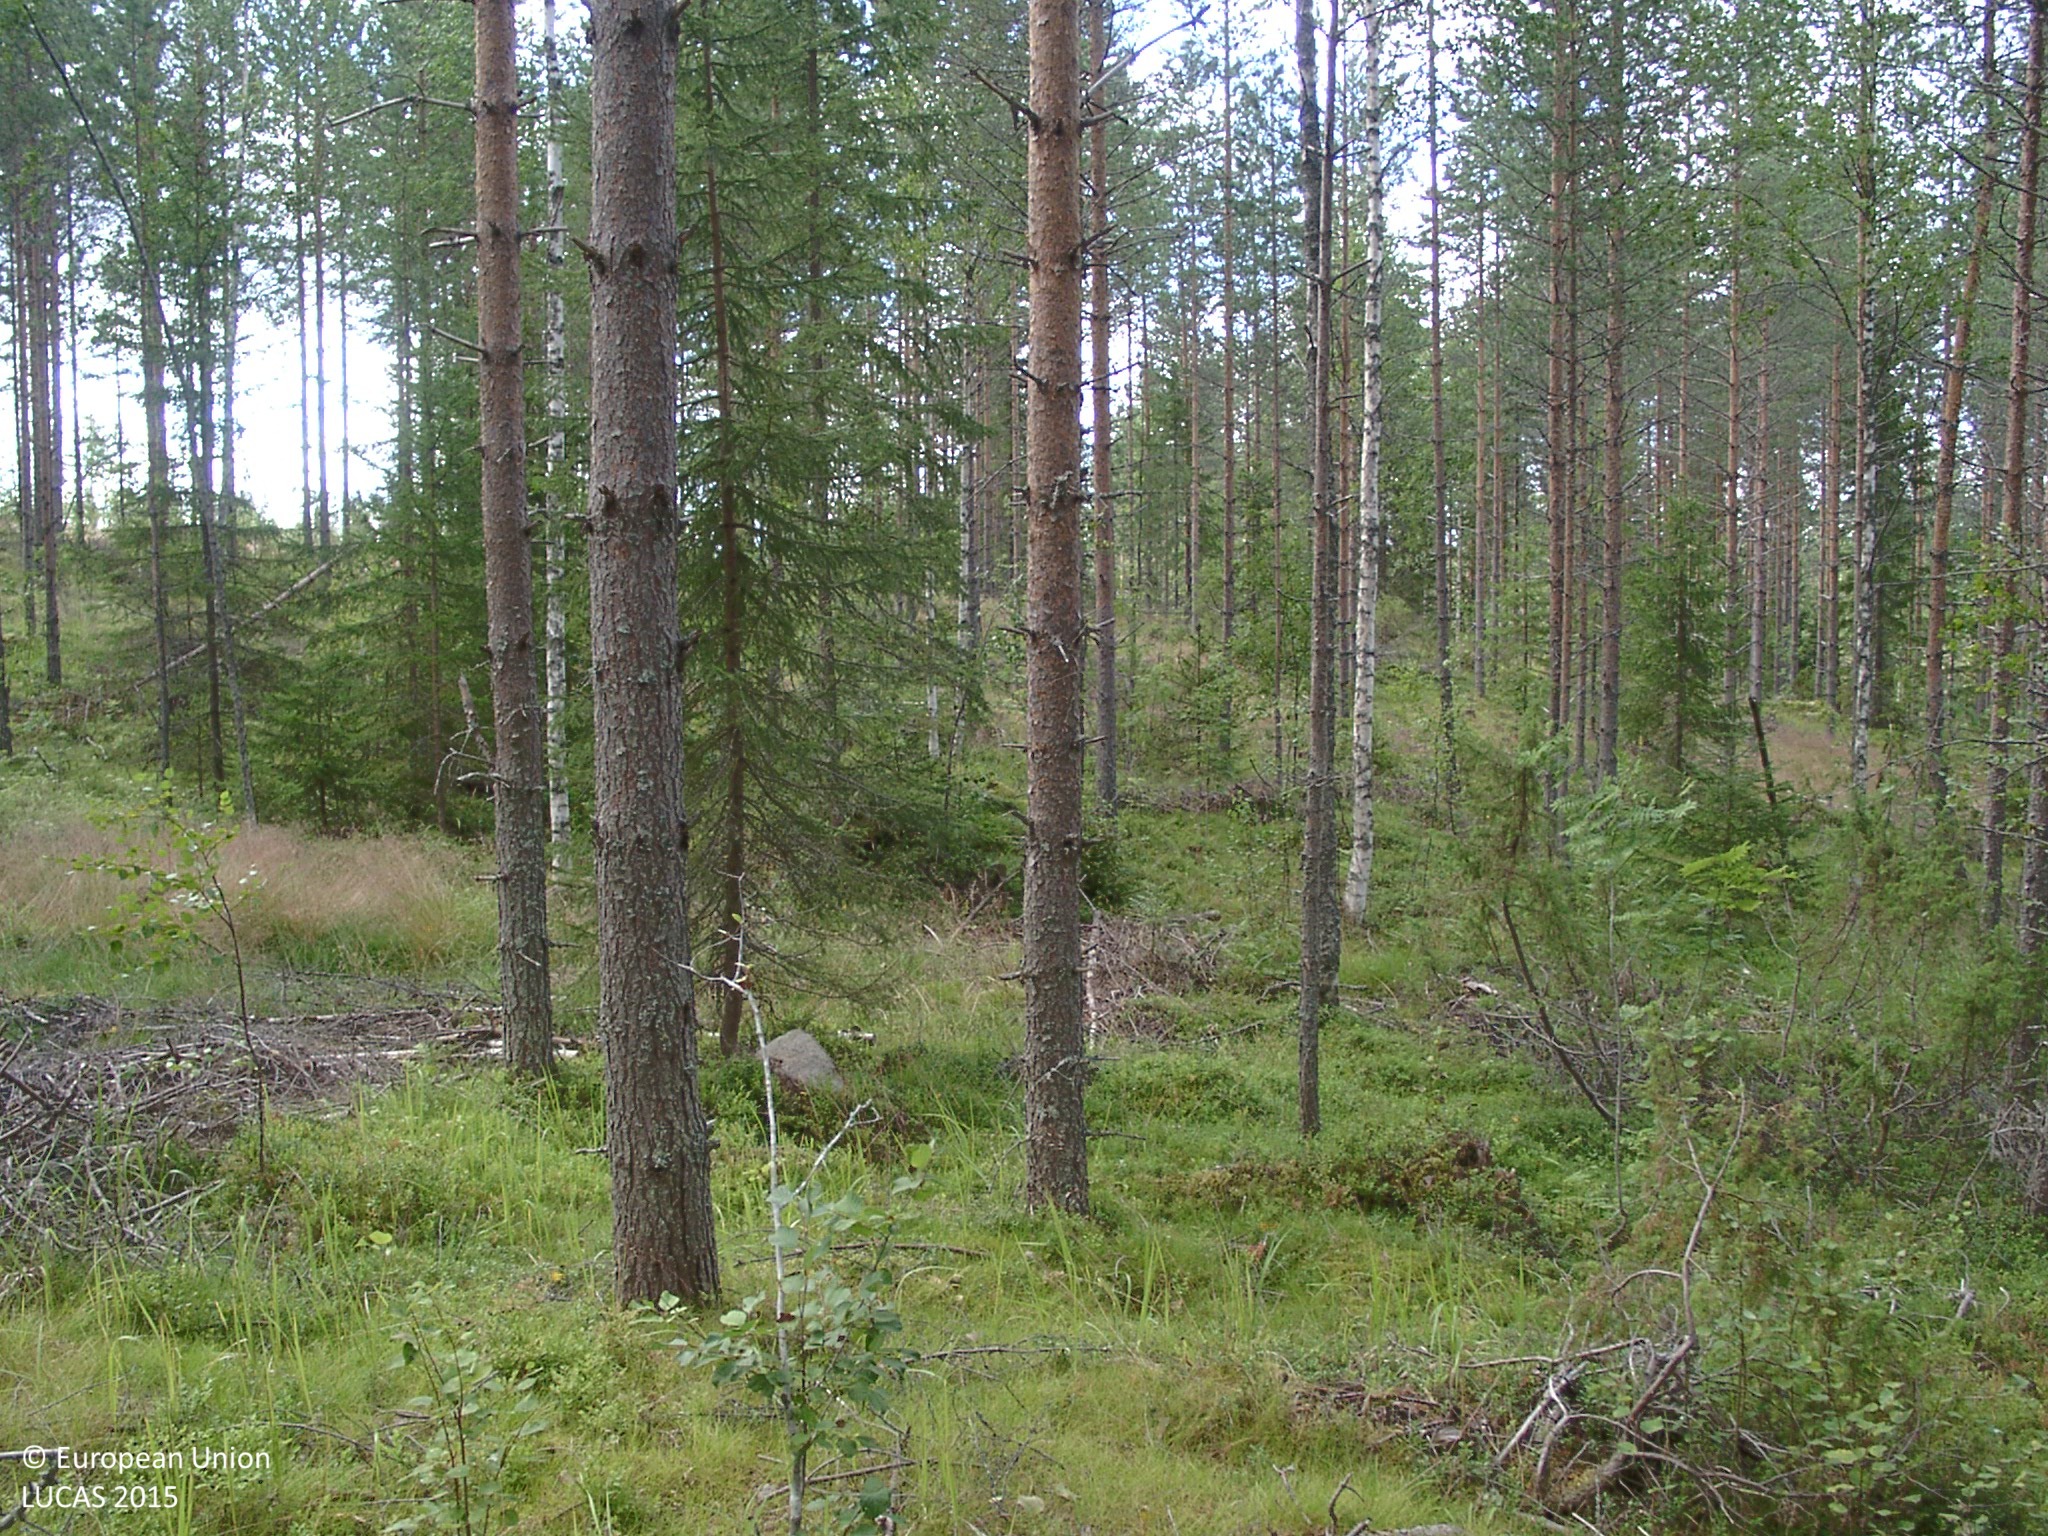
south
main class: Woodland
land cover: Pine dominated coniferous woodland
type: boreal forest
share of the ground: 50 - 75 %
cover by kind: coniferous forest trees 60 %, shrubs 10 %, herbaceous plants 10 %, lichens and mosses 10 %, broadleaved forest trees 5 %
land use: Forestry
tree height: > 5 m
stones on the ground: < 10 %
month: August
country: FI
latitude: 62.3331
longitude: 25.5389
